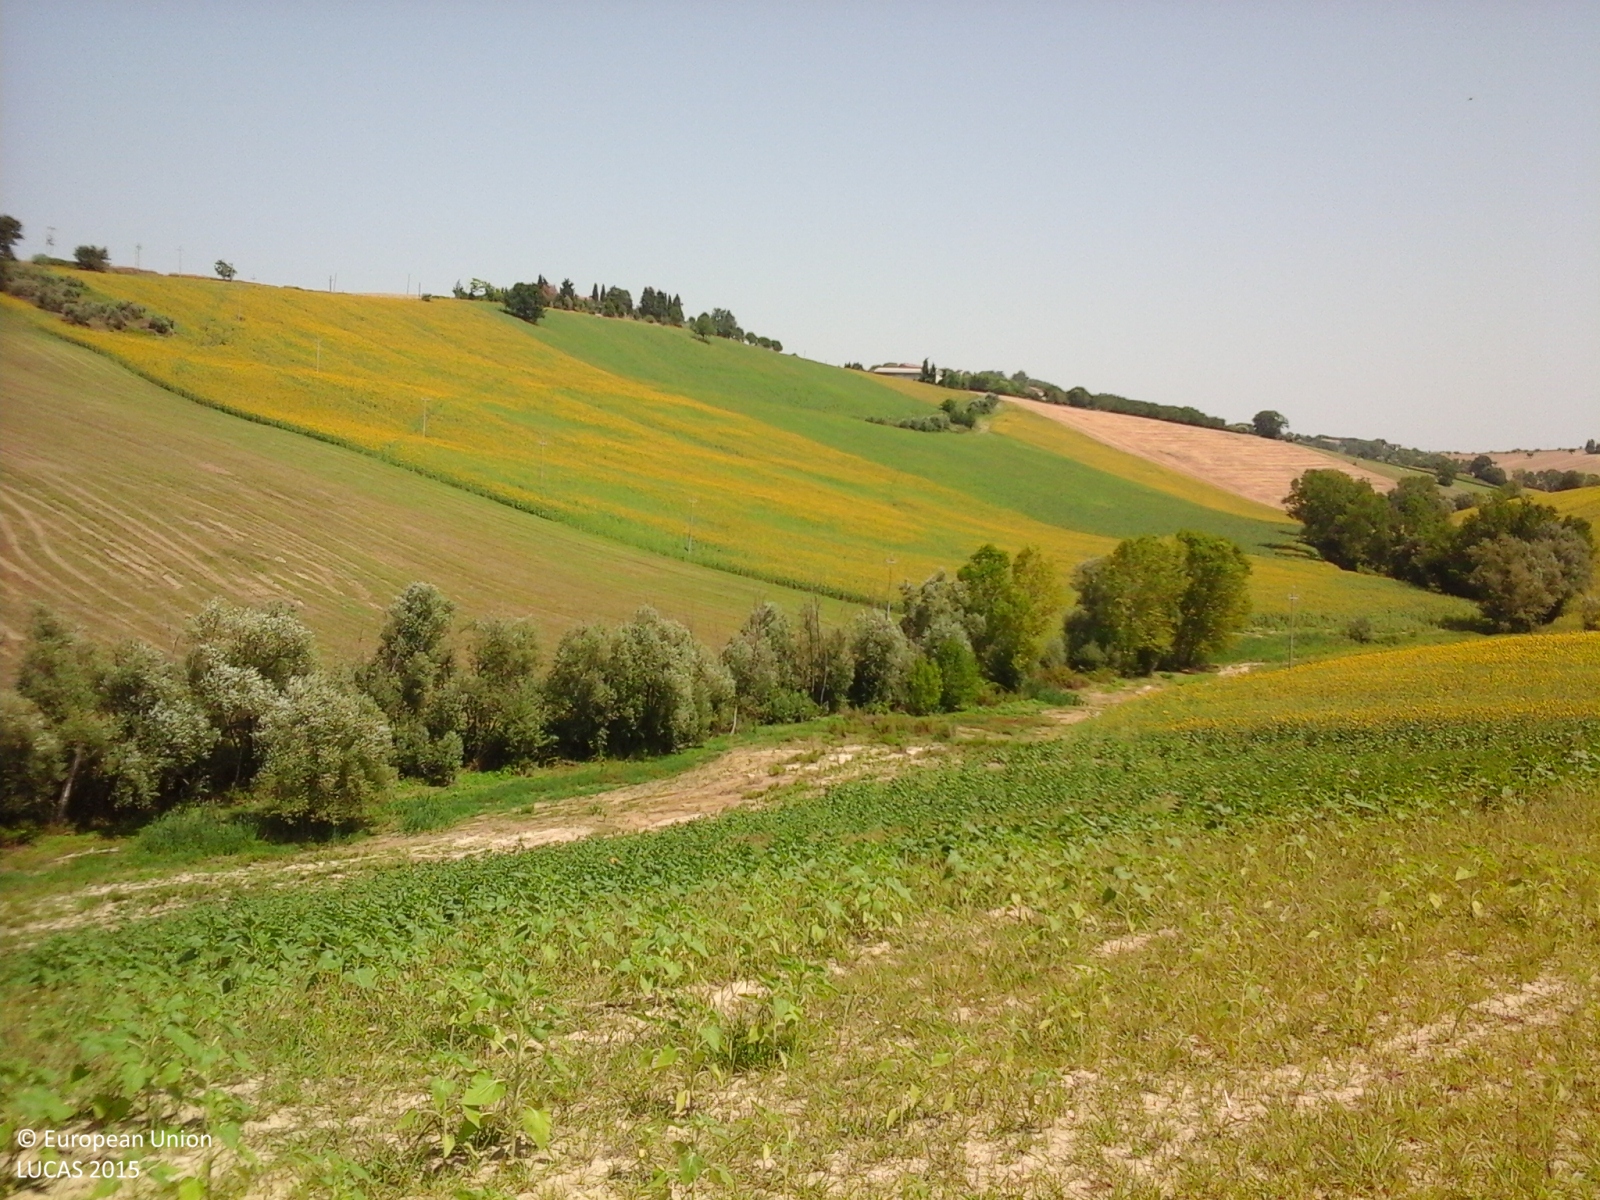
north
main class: Cropland
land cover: Sunflower
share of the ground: 25 - 50 %
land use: Agriculture (excluding fallow land and kitchen gardens)
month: July
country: IT
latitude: 43.3900
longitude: 13.4603
